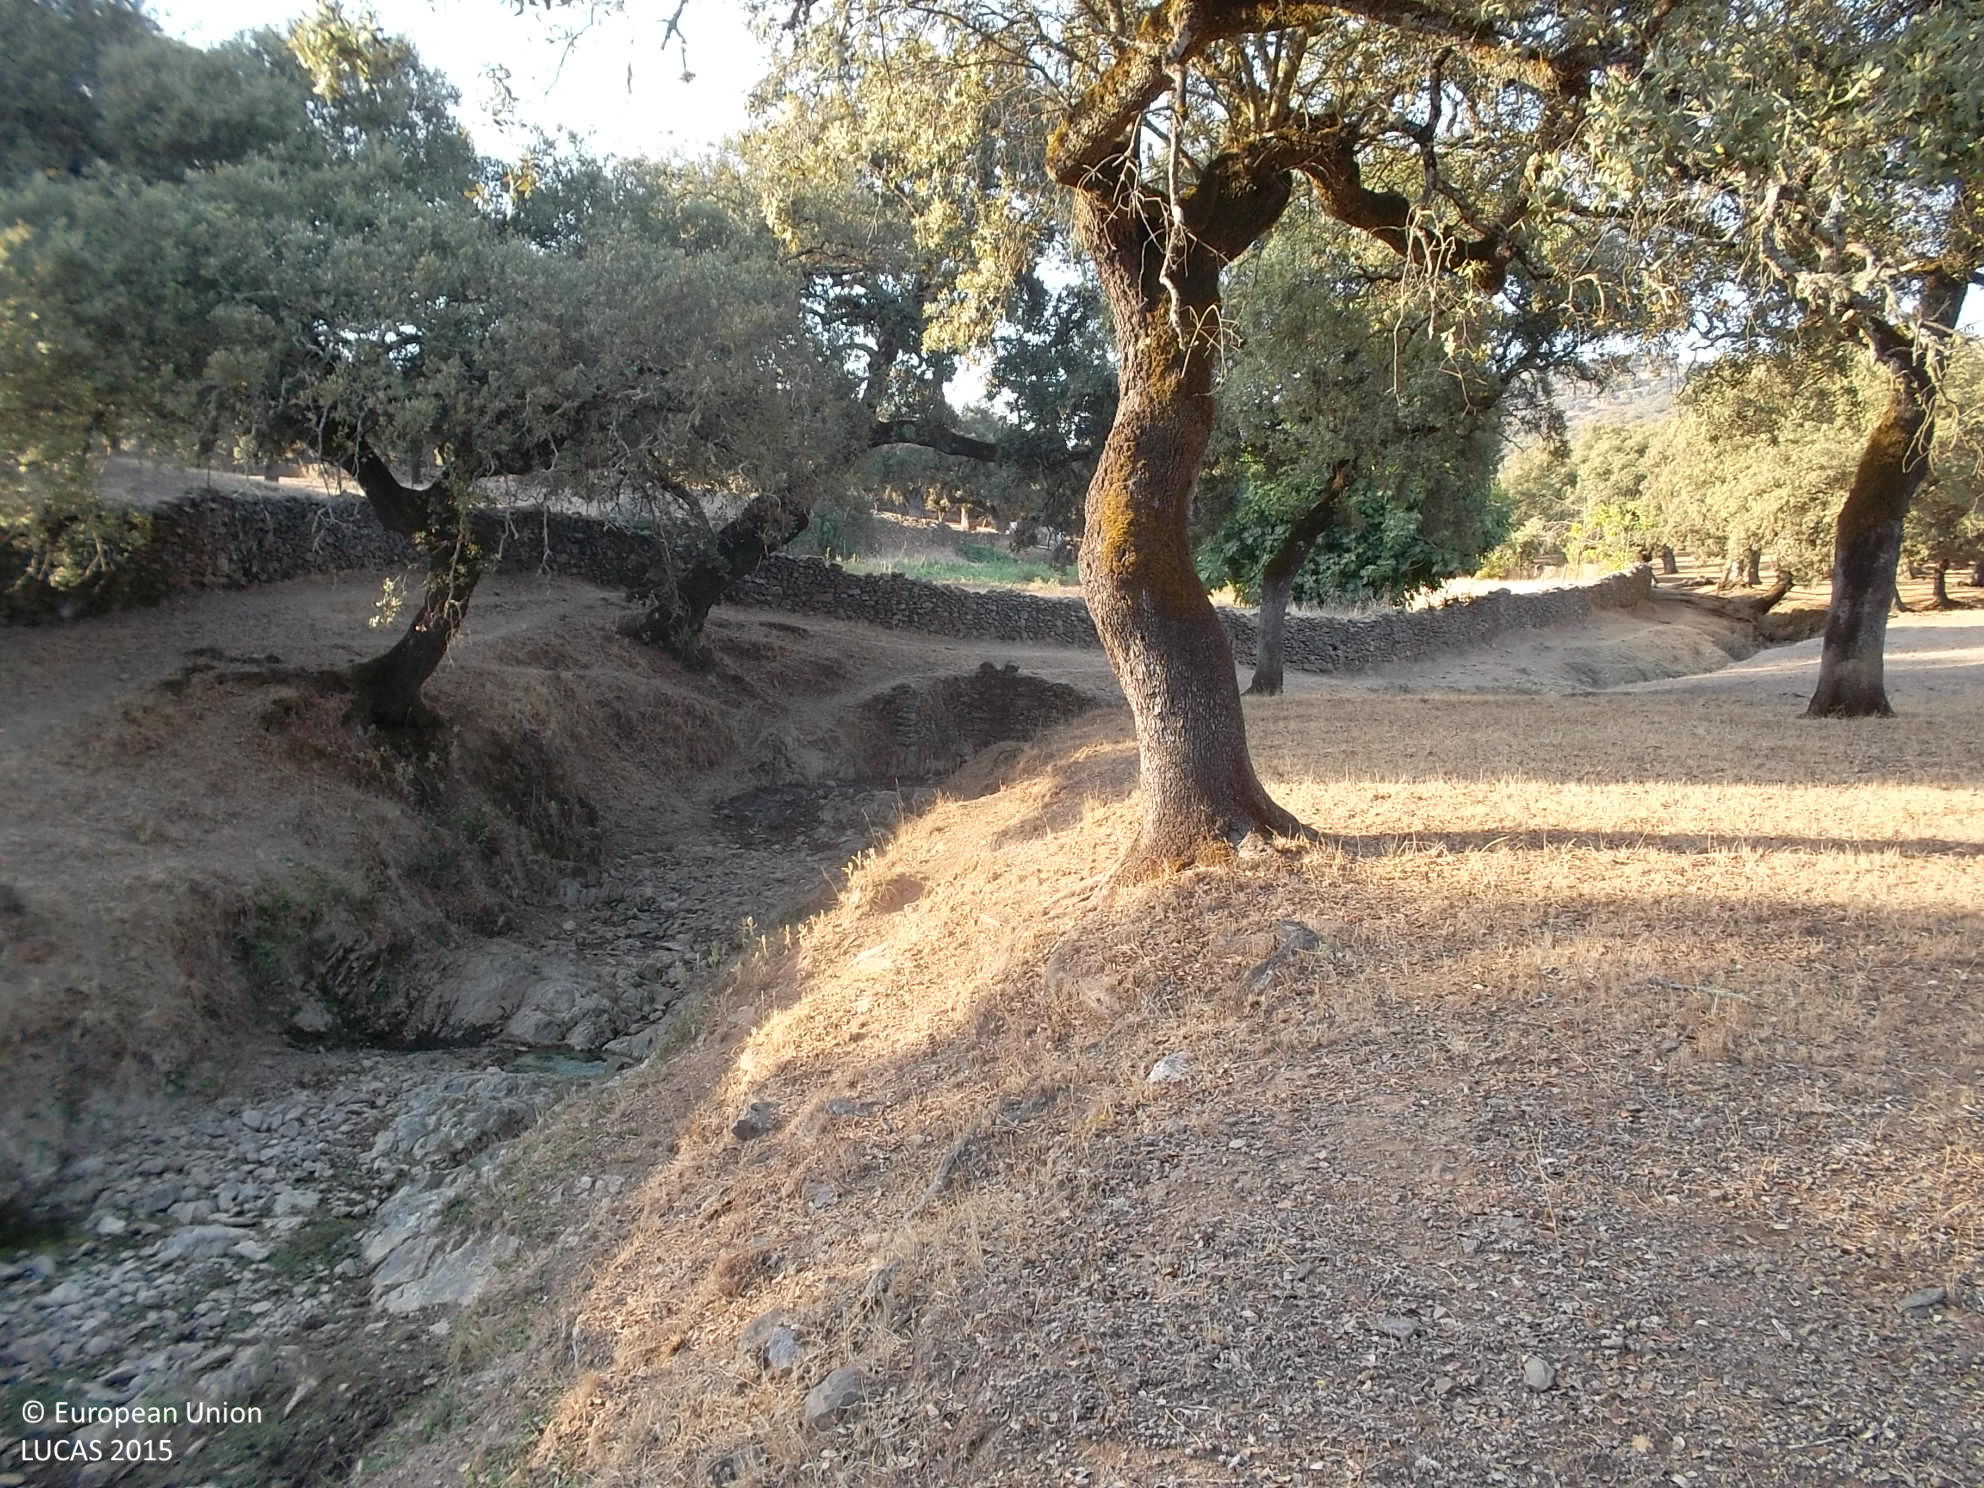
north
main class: Woodland
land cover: Broadleaved woodland
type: broadleaved evergreen forest
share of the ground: 10 - 25 %
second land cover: Grassland without tree/shrub cover
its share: > 75 %
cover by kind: herbaceous plants 80 %, broadleaved forest trees 20 %
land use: Forestry
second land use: Agriculture (excluding fallow land and kitchen gardens)
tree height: > 5 m
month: September
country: ES
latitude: 38.0425
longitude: -6.5335
